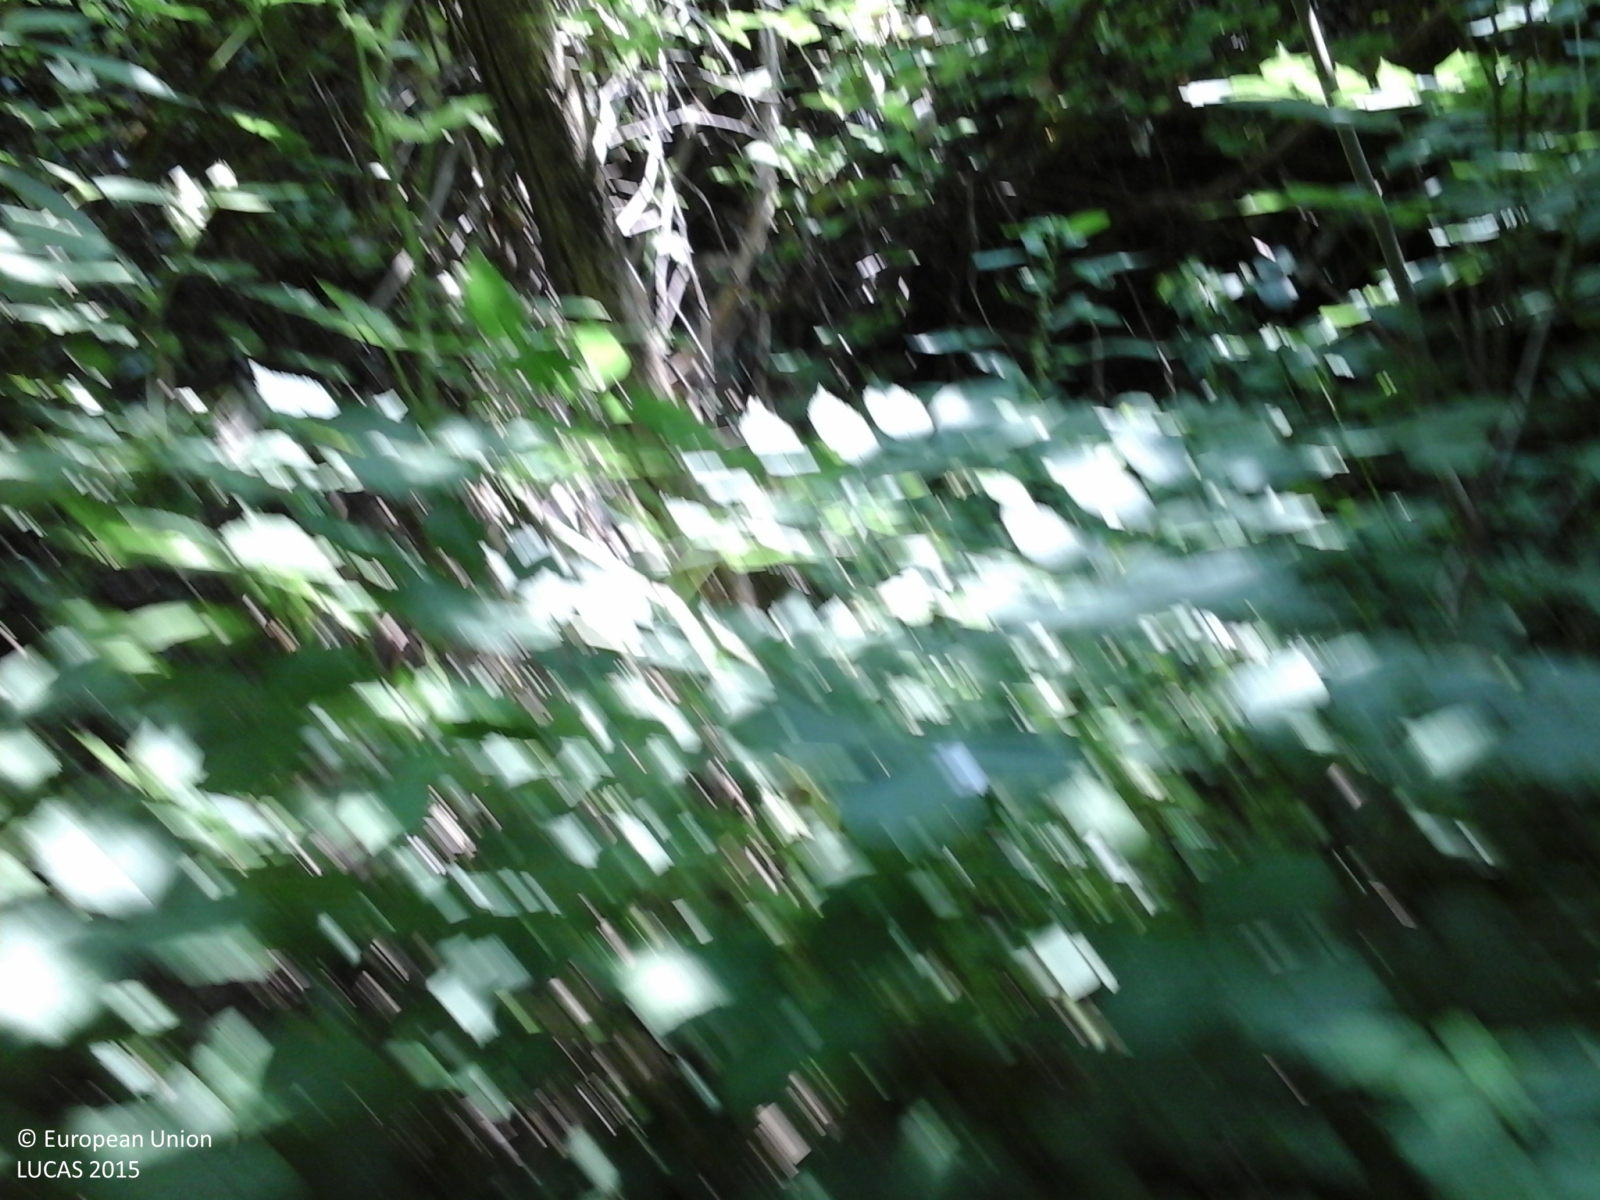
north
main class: Woodland
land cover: Broadleaved woodland
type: thermophilous deciduous forest
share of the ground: > 75 %
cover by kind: broadleaved forest trees 100 %
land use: Semi-natural and natural areas not in use
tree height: > 5 m
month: June
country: IT
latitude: 45.7810
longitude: 11.5796
